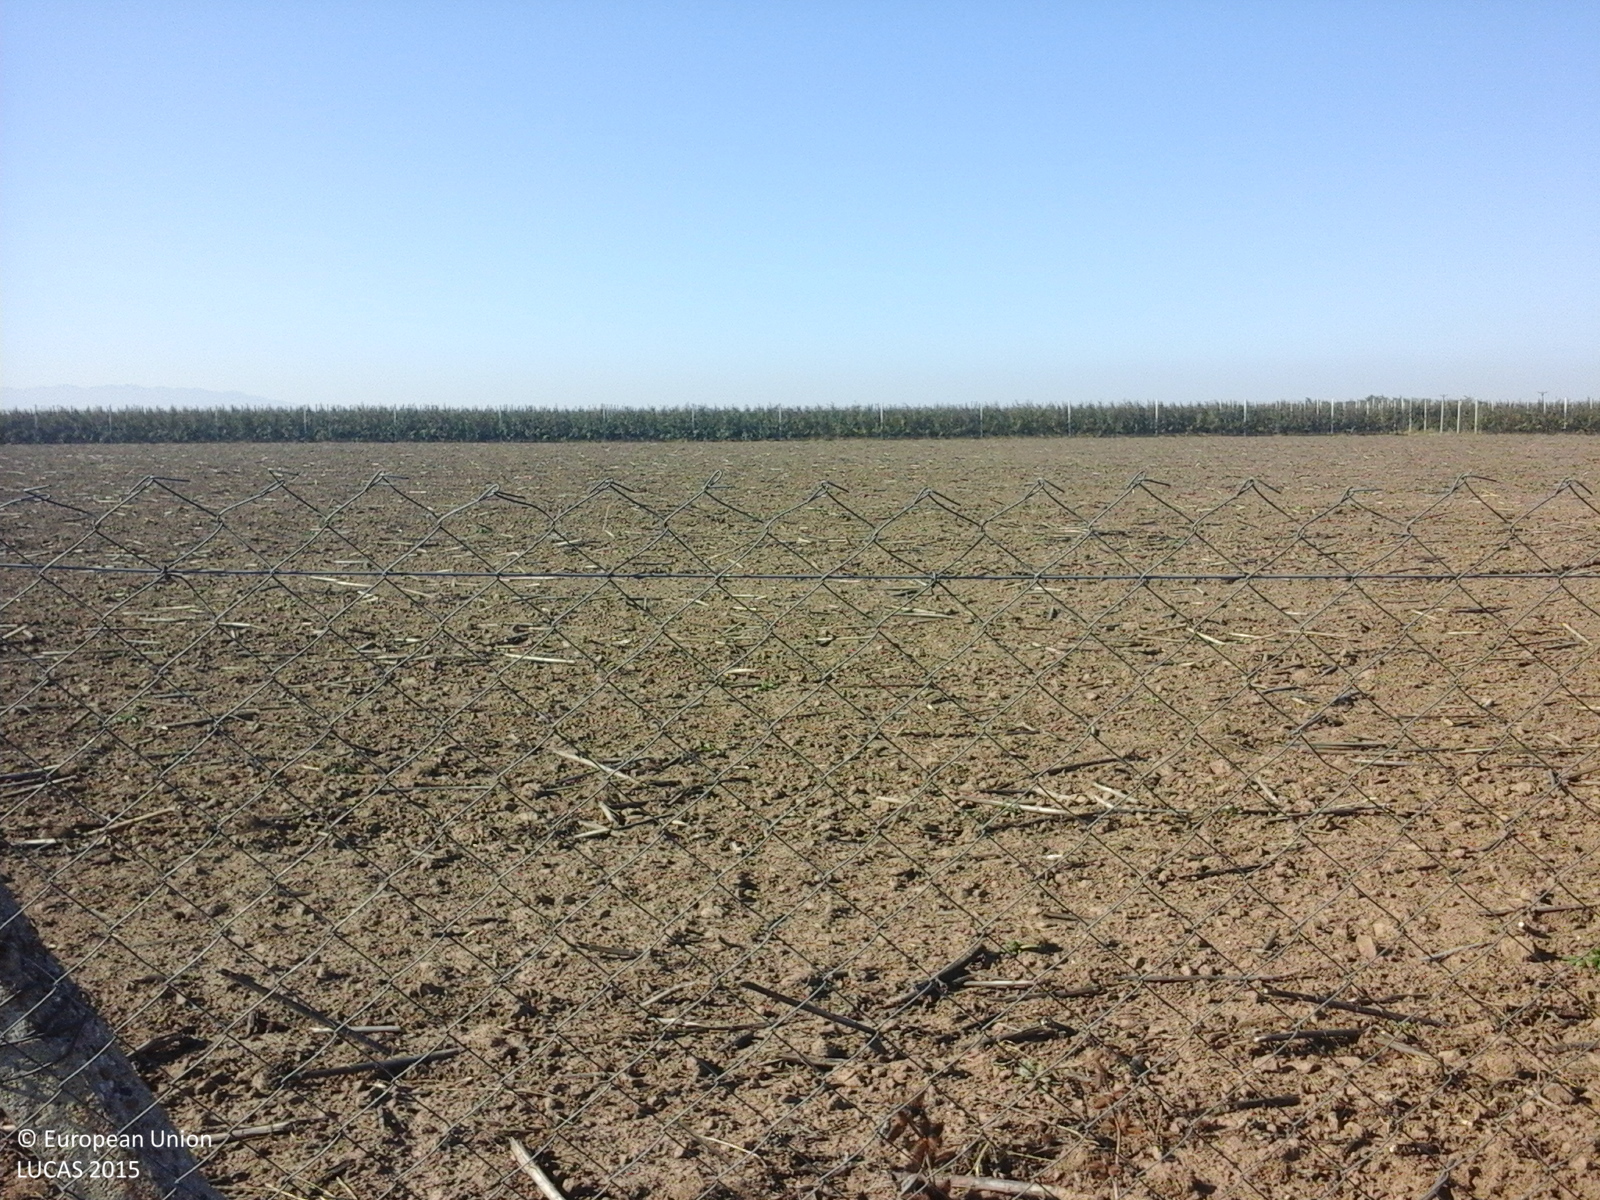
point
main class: Cropland
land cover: Sunflower
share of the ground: 10 - 25 %
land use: Agriculture (excluding fallow land and kitchen gardens)
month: October
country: RO
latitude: 45.9791
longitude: 27.1736
